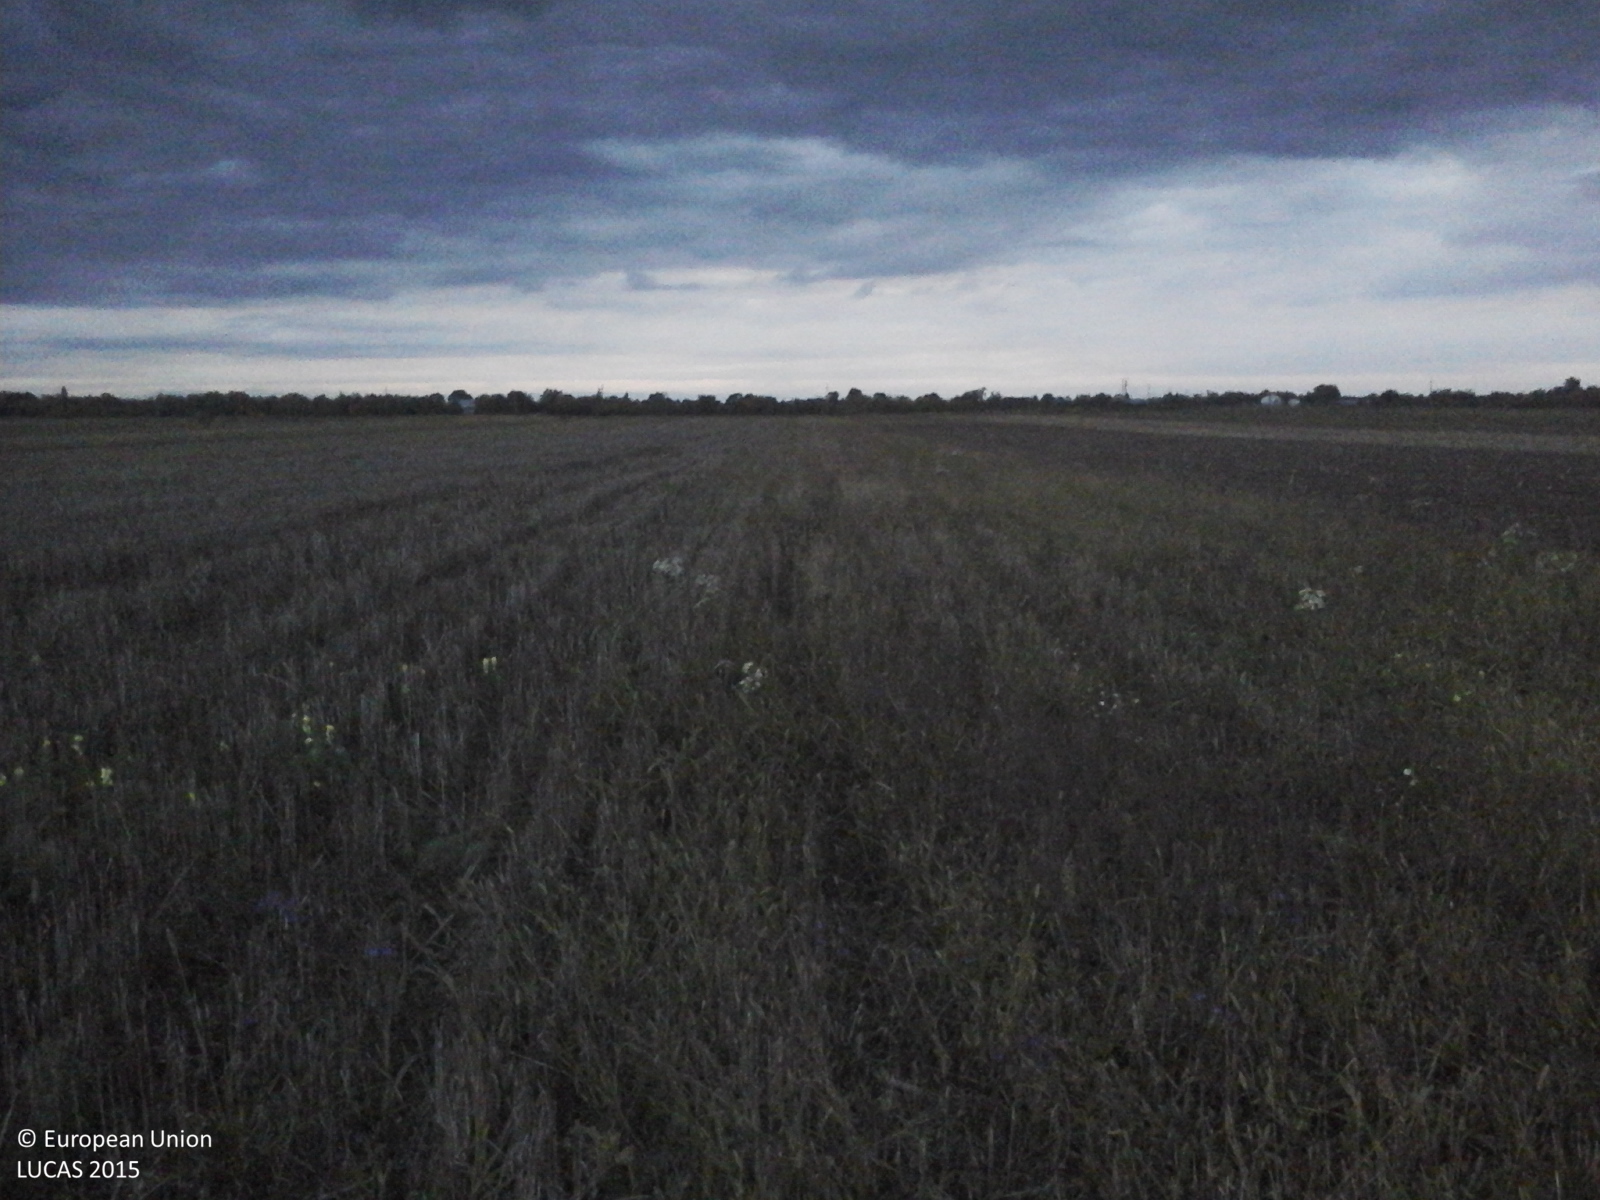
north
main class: Grassland
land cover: Spontaneously vegetated surfaces
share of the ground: > 75 %
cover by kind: herbaceous plants 100 %
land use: Fallow land
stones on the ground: < 10 %
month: October
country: RO
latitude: 44.7227
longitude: 25.9488
